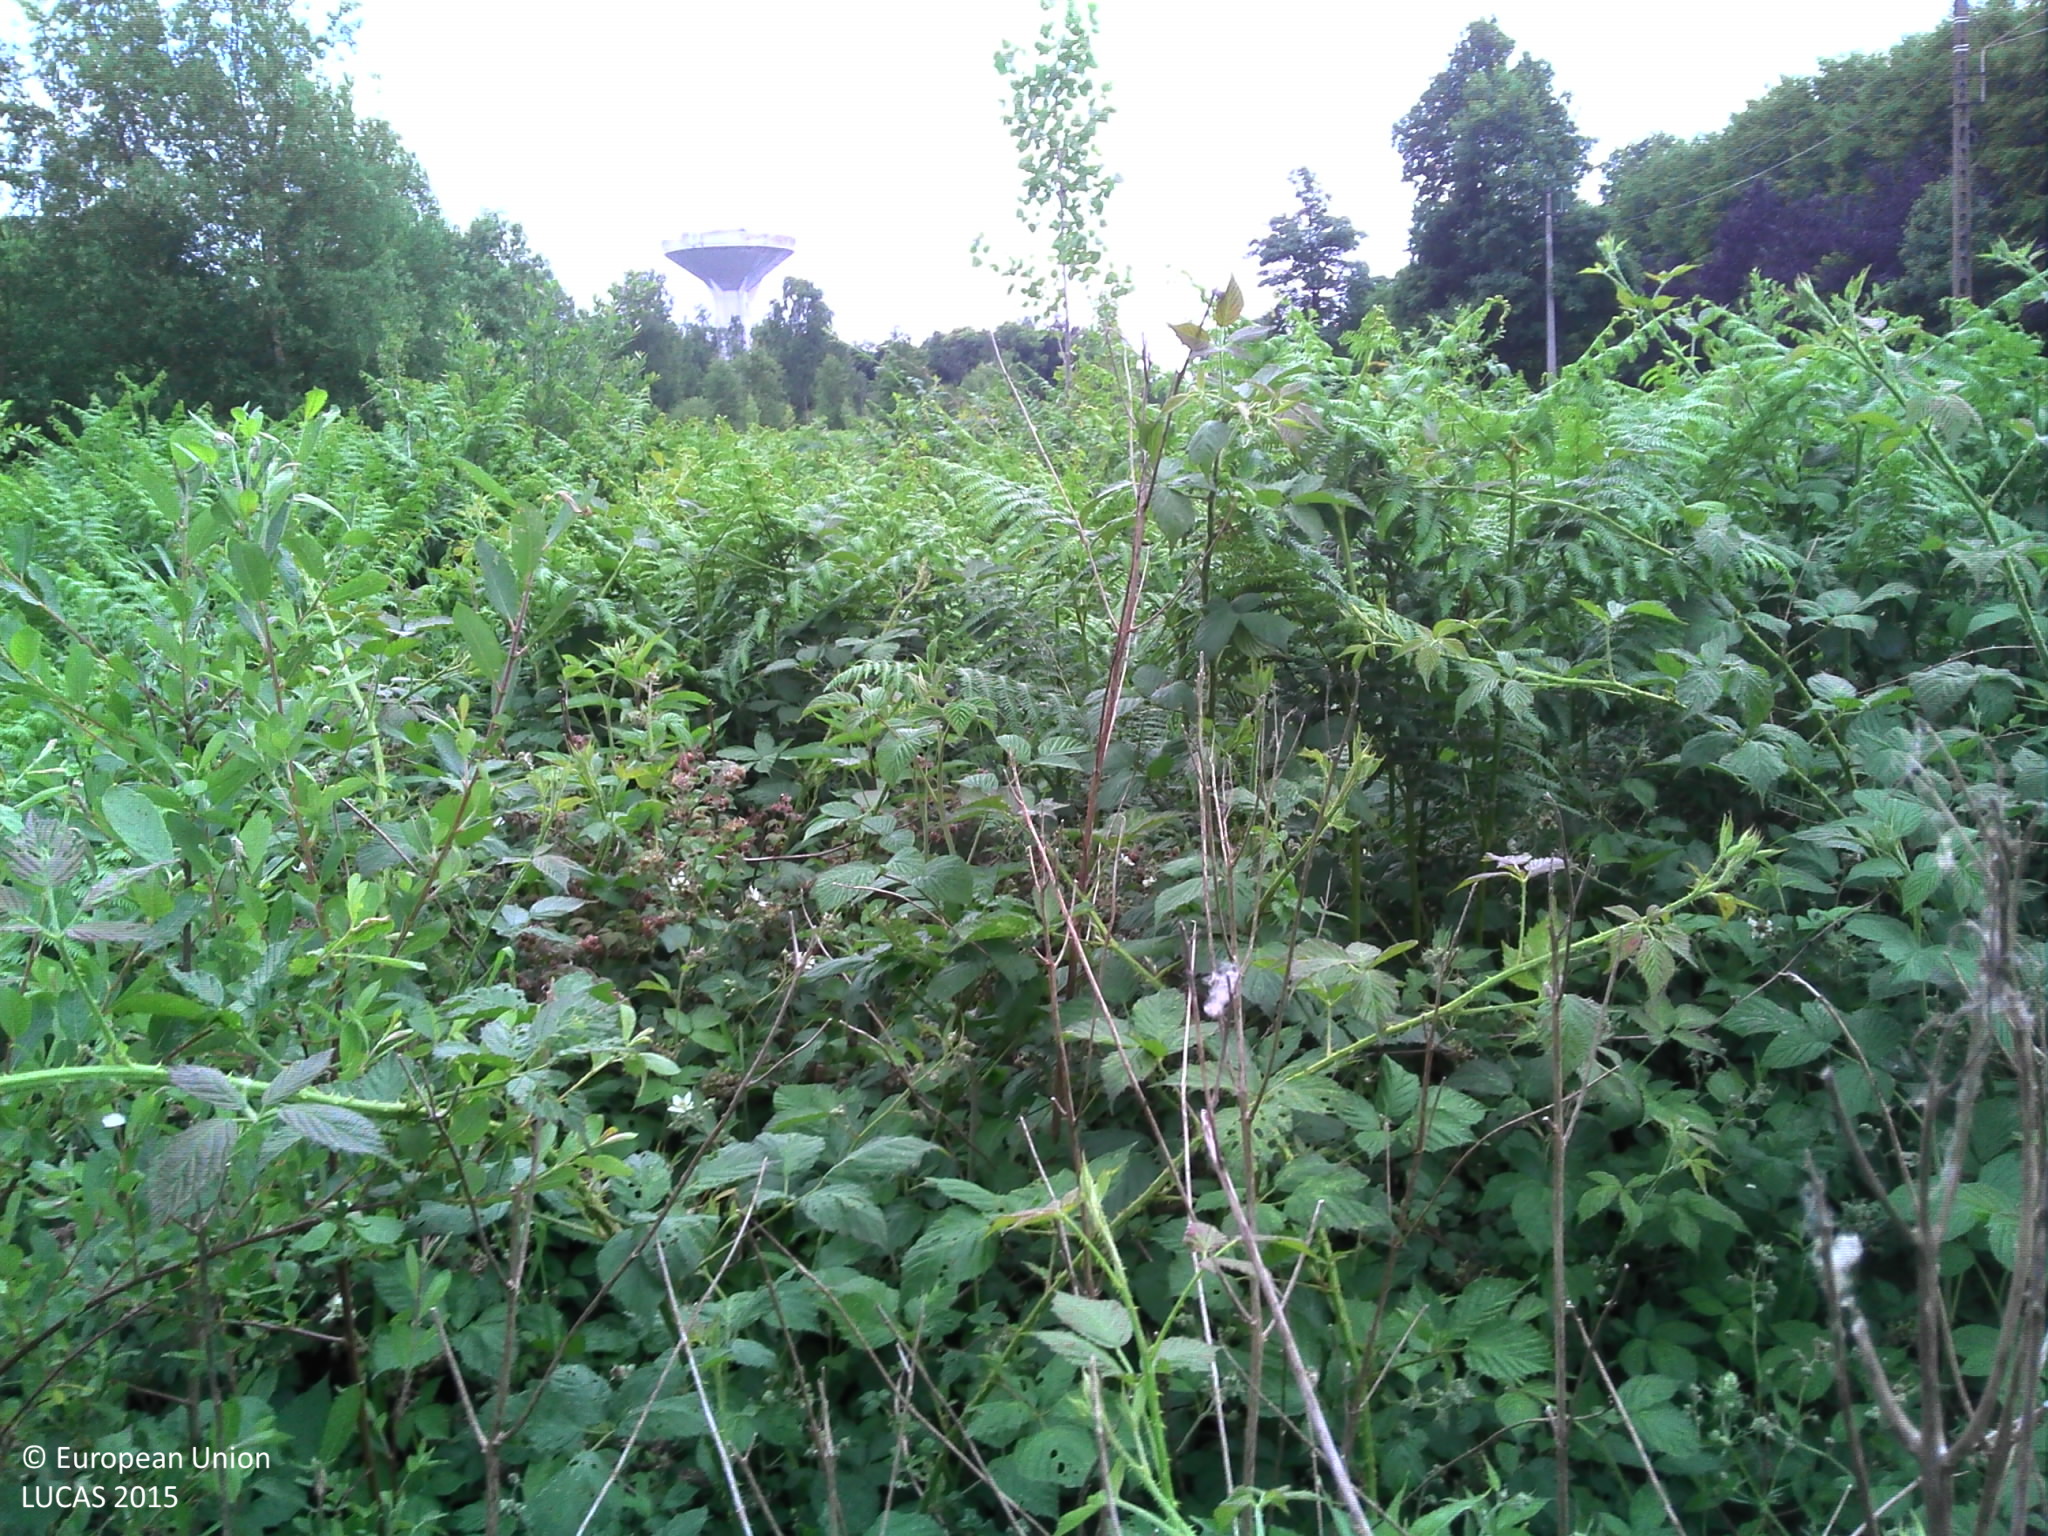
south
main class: Shrubland
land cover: Shrubland with sparse tree cover
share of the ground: > 75 %
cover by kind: shrubs 70 %, herbaceous plants 25 %, broadleaved forest trees 5 %
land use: Semi-natural and natural areas not in use
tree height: < 5 m
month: June
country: BE
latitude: 50.5042
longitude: 3.8321
